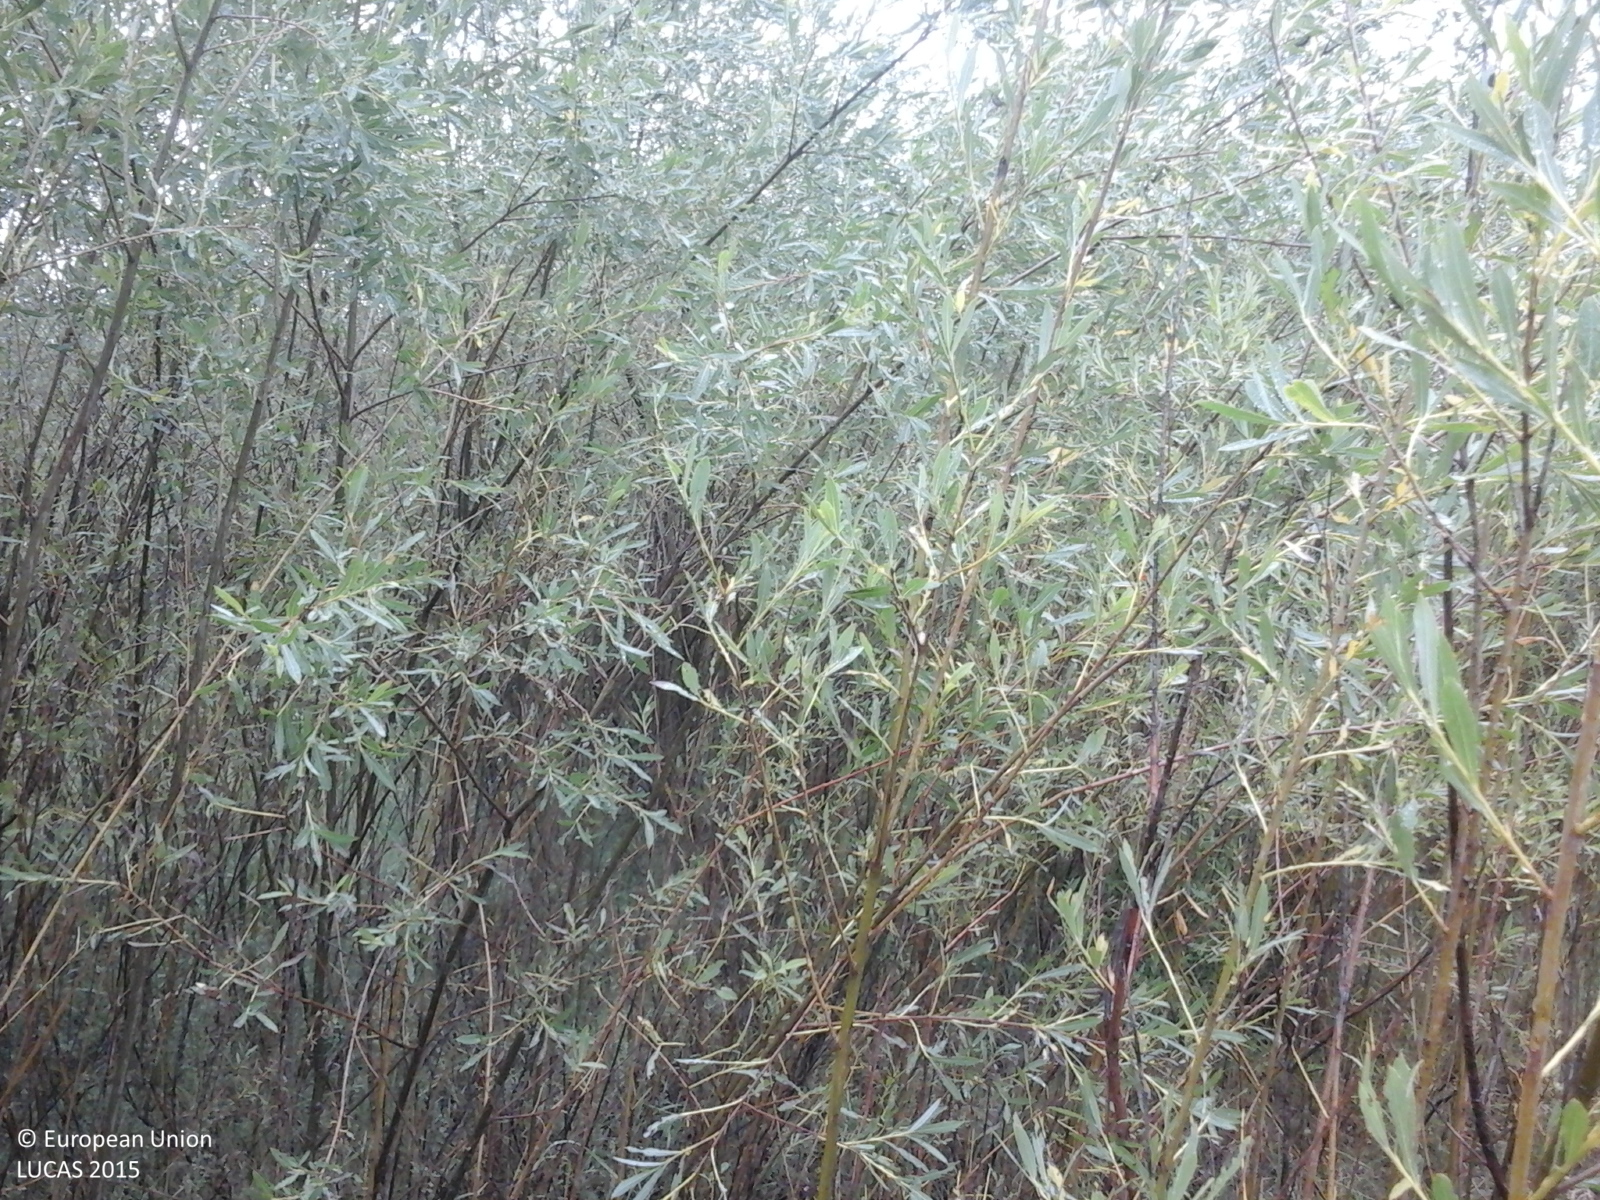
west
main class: Shrubland
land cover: Shrubland without tree cover
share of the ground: 50 - 75 %
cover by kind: shrubs 75 %, herbaceous plants 25 %
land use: Semi-natural and natural areas not in use
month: June
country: RO
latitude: 47.3542
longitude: 26.3815
